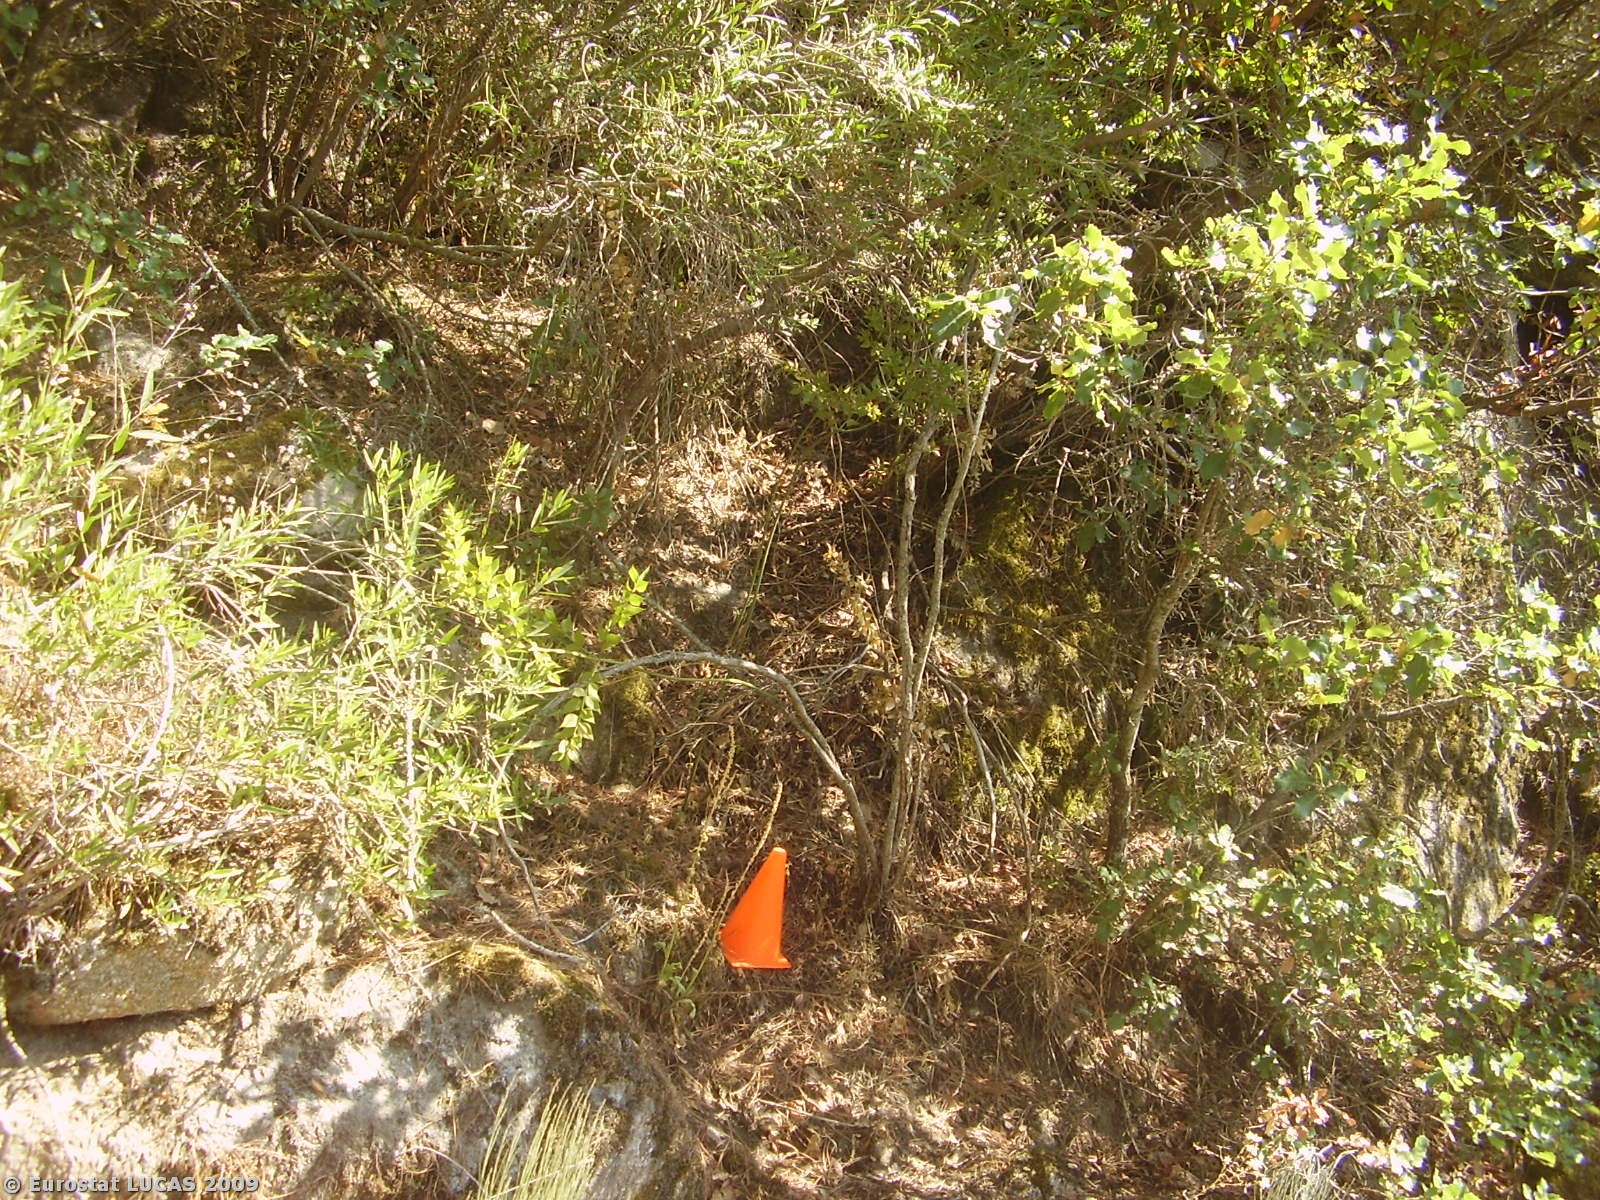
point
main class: Woodland
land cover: Mixed woodland
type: mesophytic deciduous forest
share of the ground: 10 - 25 %
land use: Forestry
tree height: > 5 m
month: August
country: PT
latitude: 41.4003
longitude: -7.0390
